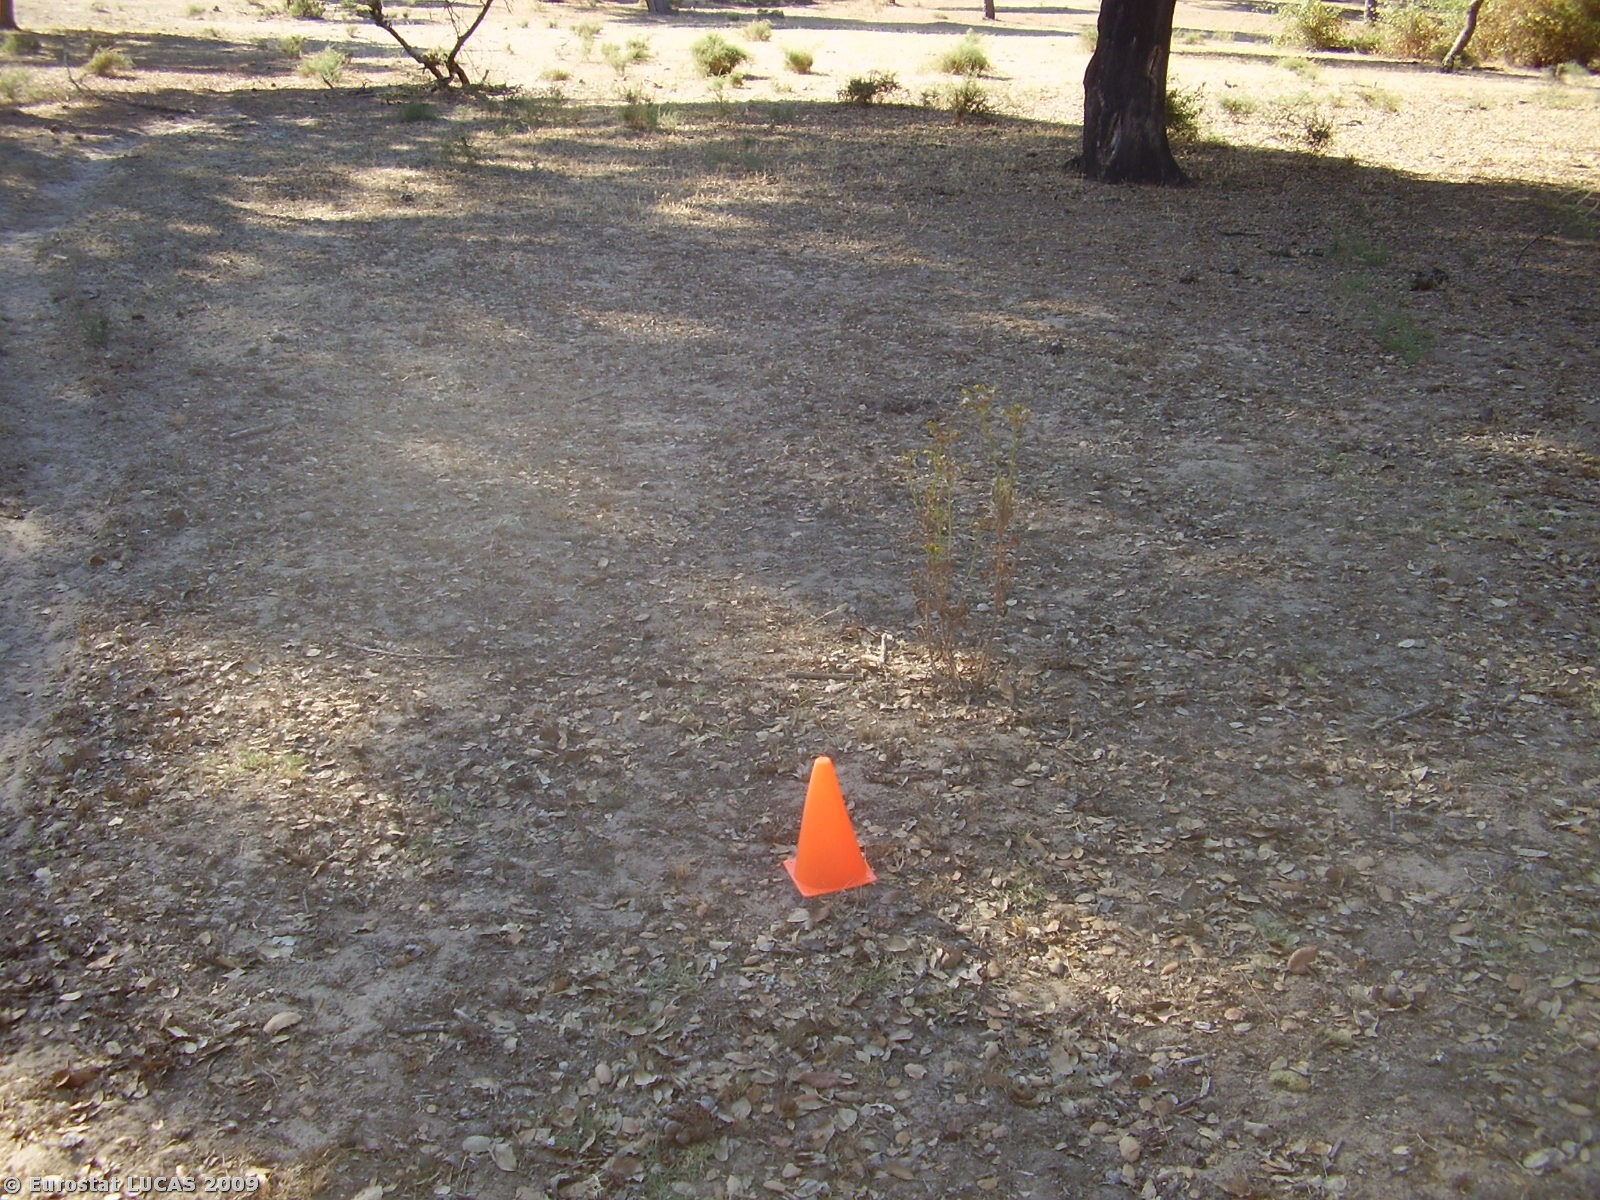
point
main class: Woodland
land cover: Mixed woodland
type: mesophytic deciduous forest
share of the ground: 10 - 25 %
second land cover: Grassland with sparse tree/shrub cover
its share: 10 - 25 %
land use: Forestry
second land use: Fallow land
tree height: > 5 m
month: July
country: PT
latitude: 38.2711
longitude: -8.3912
